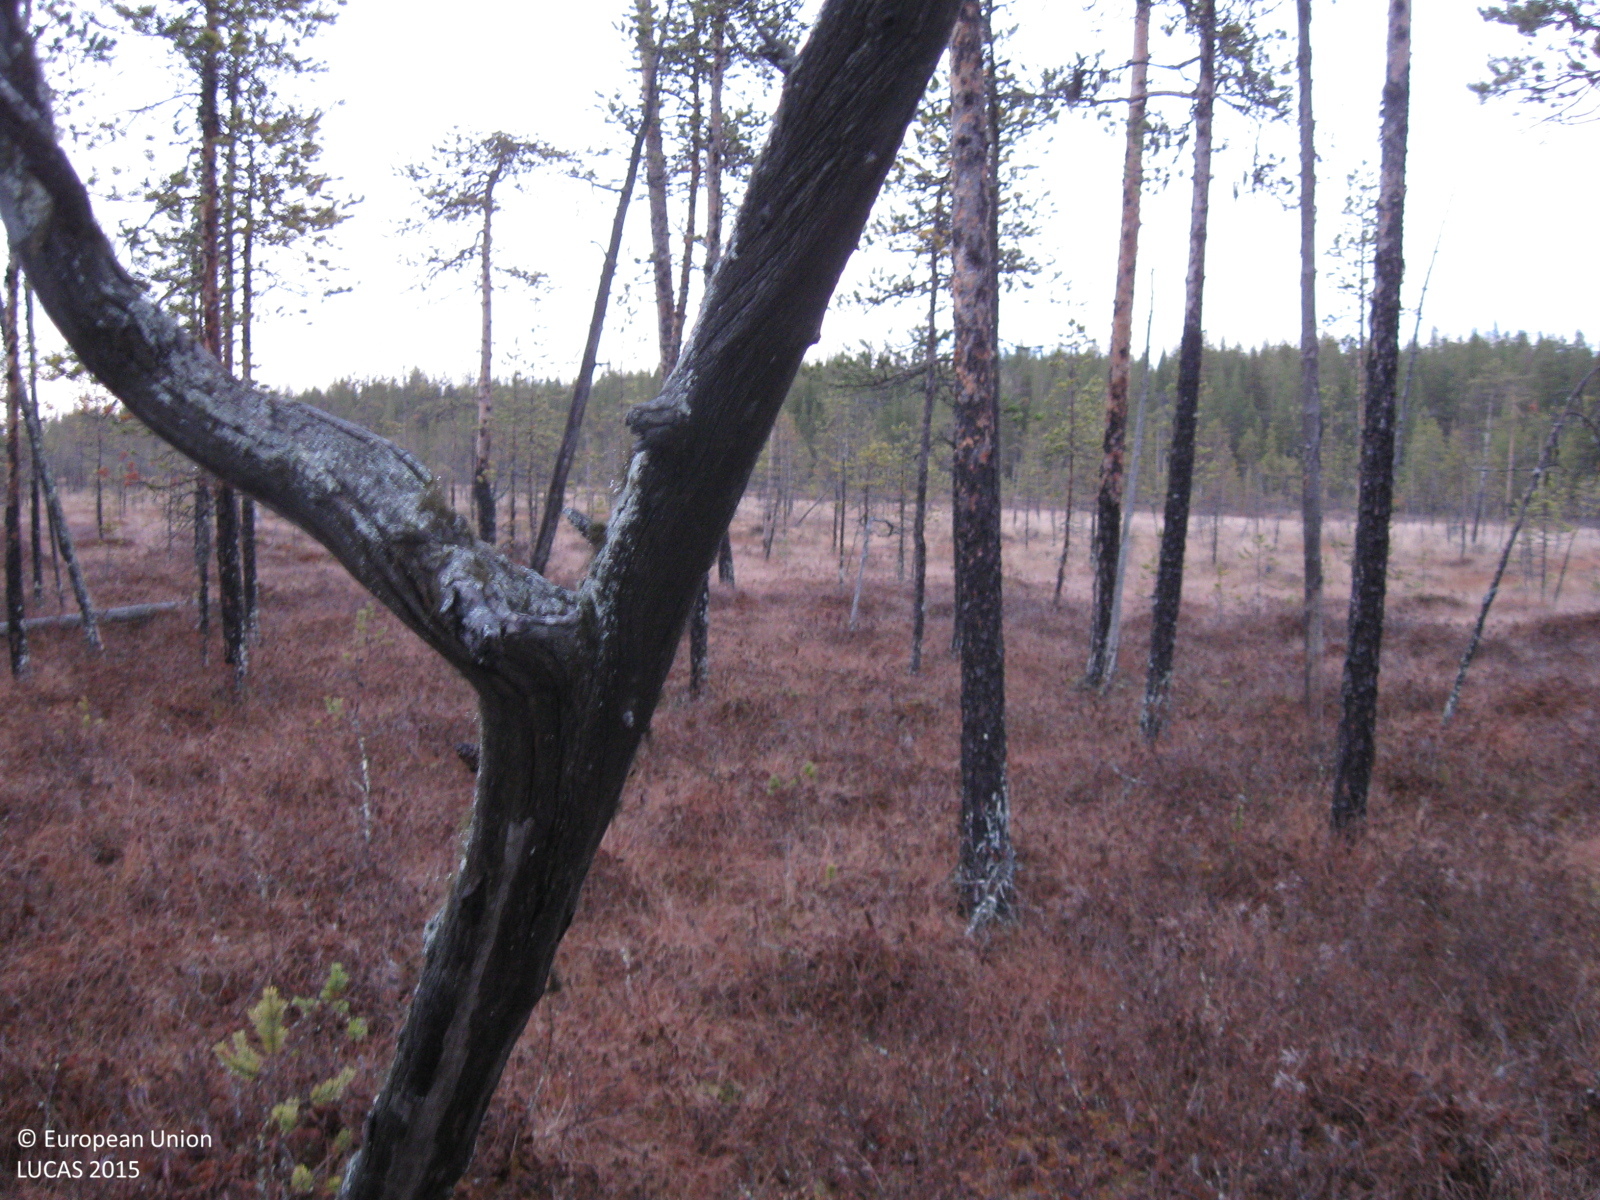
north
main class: Woodland
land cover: Pine dominated coniferous woodland
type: mire and swamp forests
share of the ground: 25 - 50 %
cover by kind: shrubs 40 %, coniferous forest trees 35 %, herbaceous plants 15 %, lichens and mosses 10 %
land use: Semi-natural and natural areas not in use
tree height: < 5 m
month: October
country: SE
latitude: 66.4341
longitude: 20.9201
